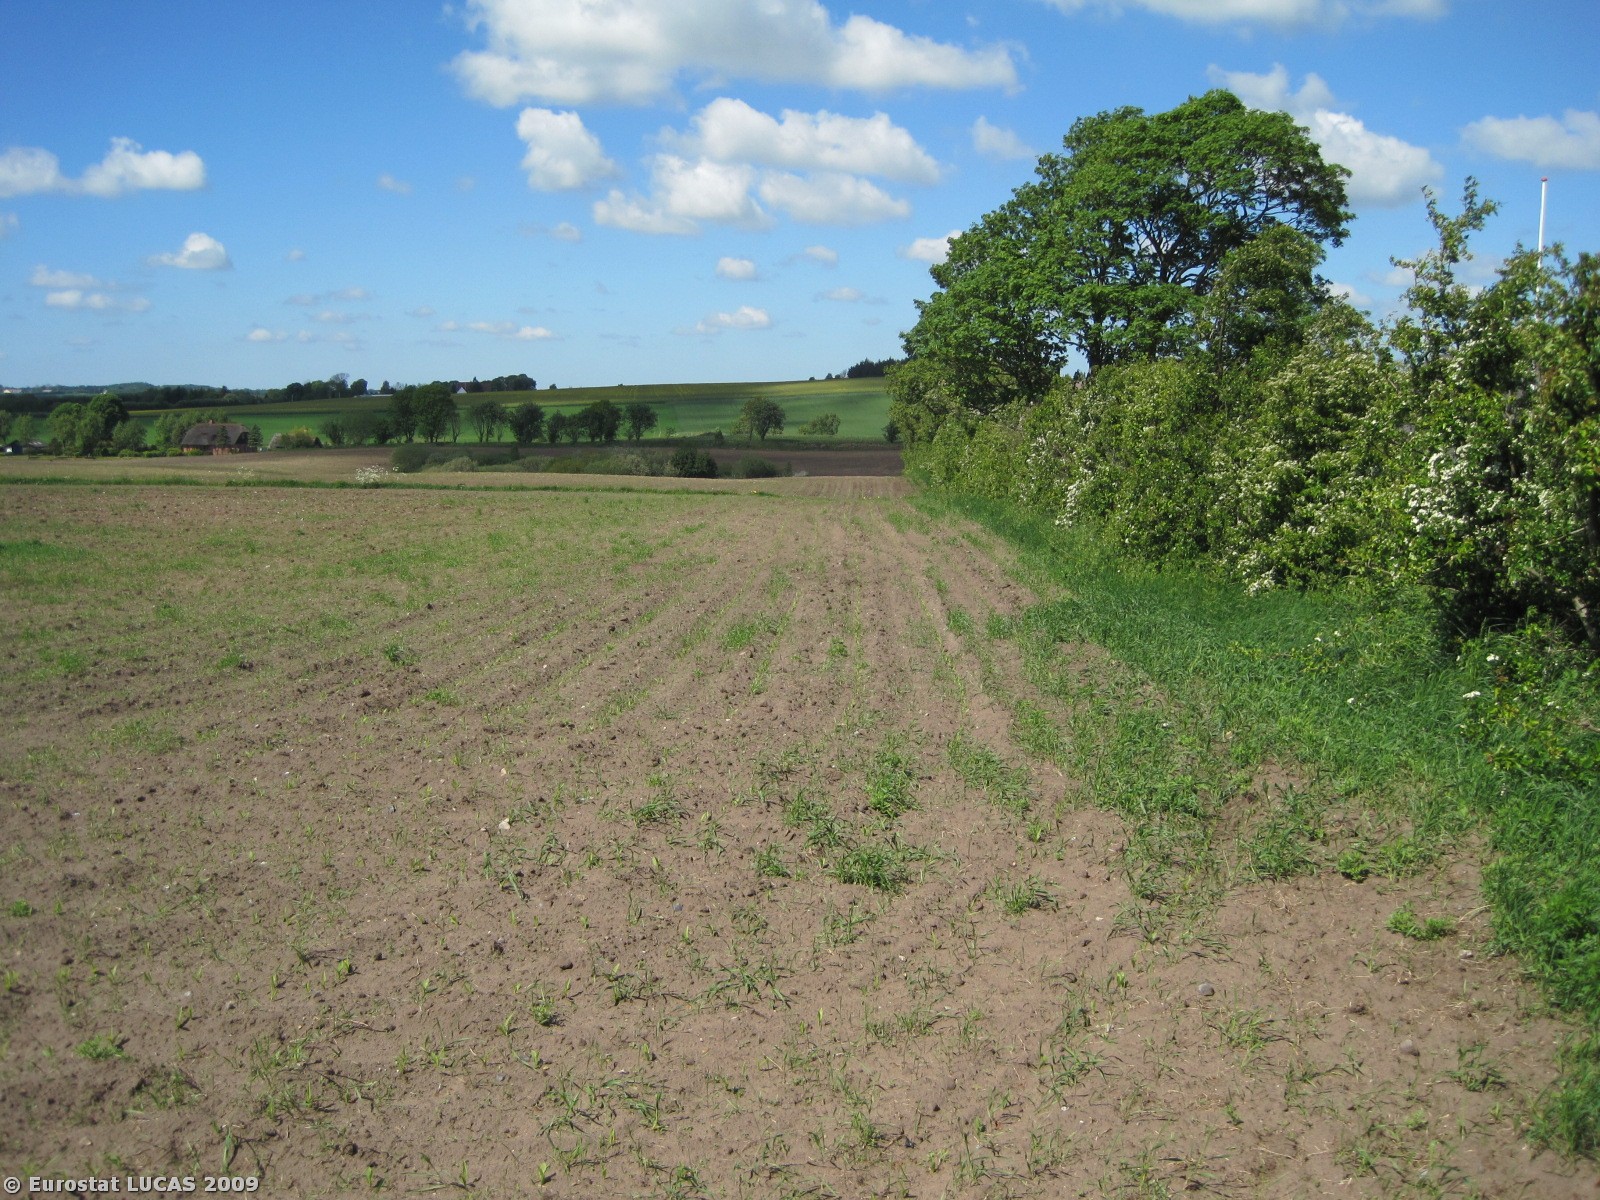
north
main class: Cropland
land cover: Maize
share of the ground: 10 - 25 %
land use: Agriculture (excluding fallow land and kitchen gardens)
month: May
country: DK
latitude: 56.8349
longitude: 10.0491
